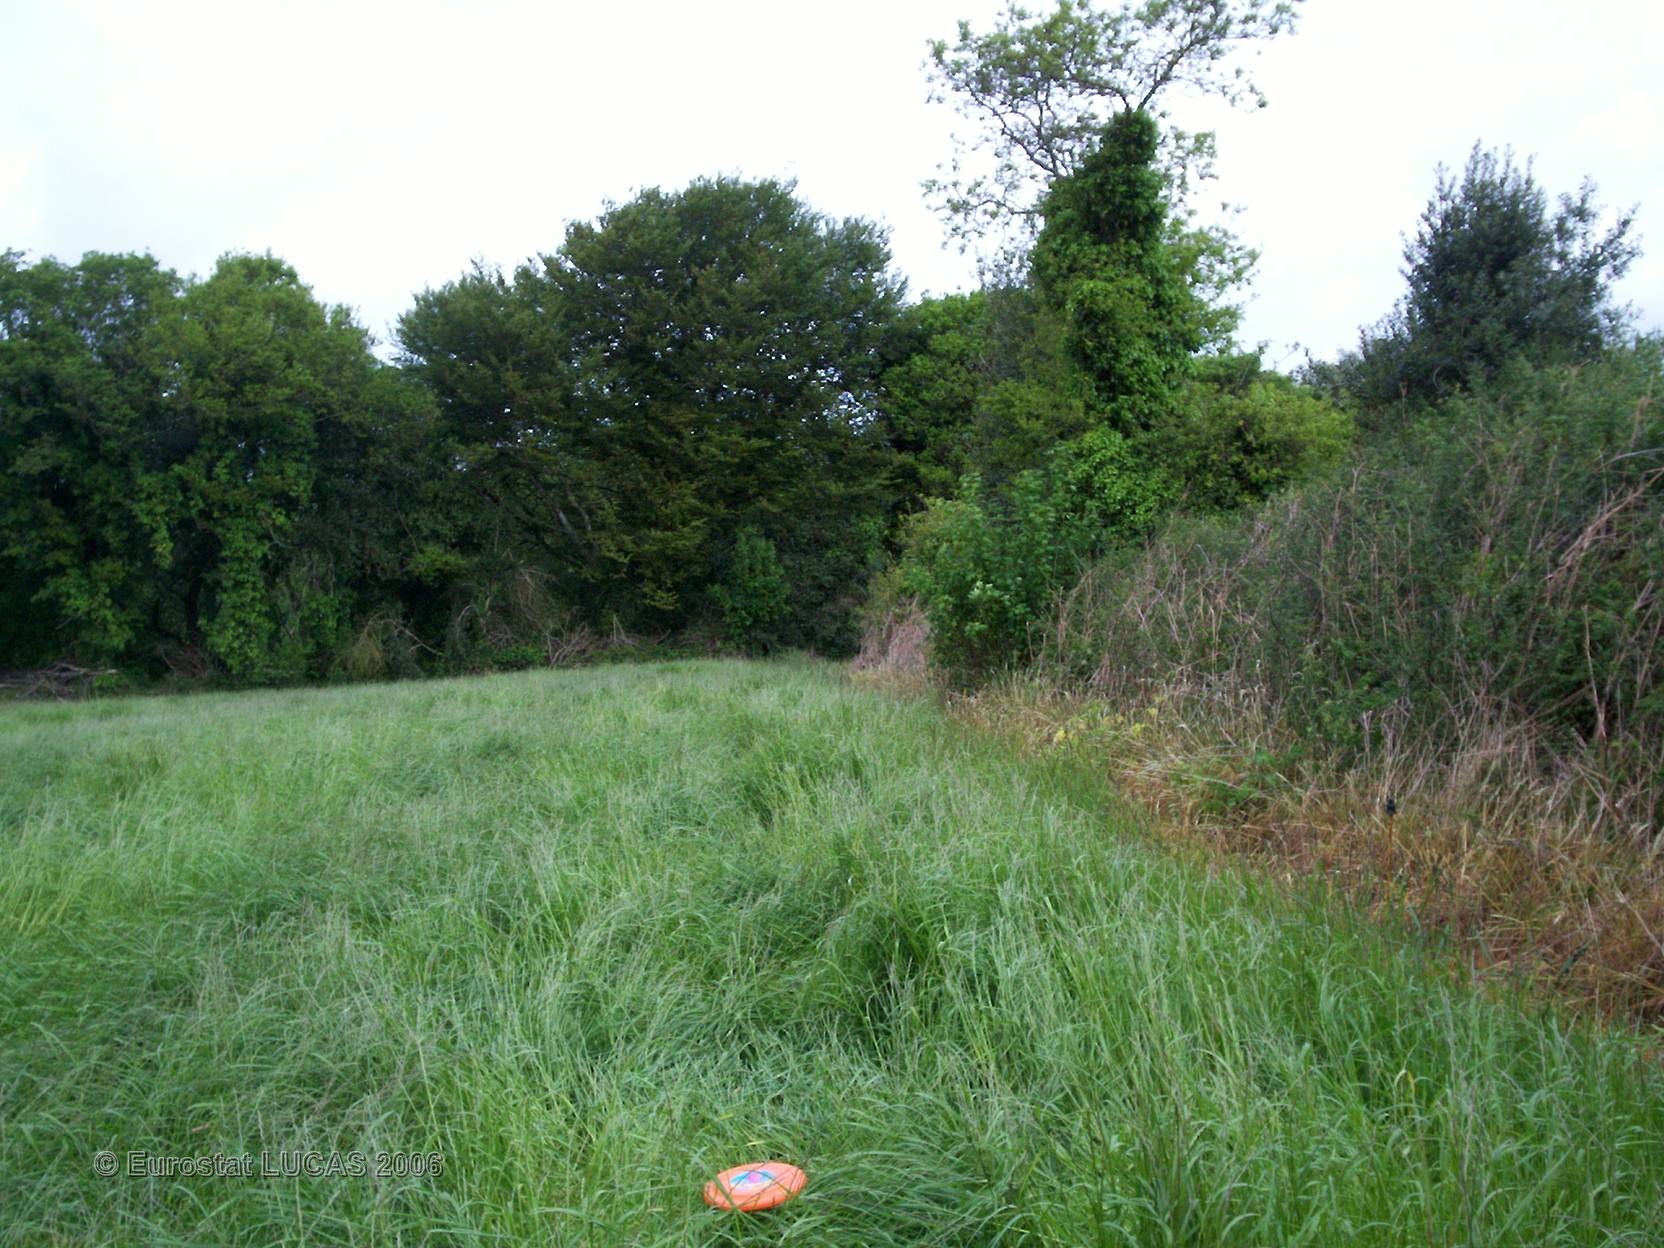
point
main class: Grassland
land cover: Grassland without tree/shrub cover
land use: Agriculture (excluding fallow land and kitchen gardens)
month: May
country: FR
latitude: 47.9771
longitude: -3.8960
